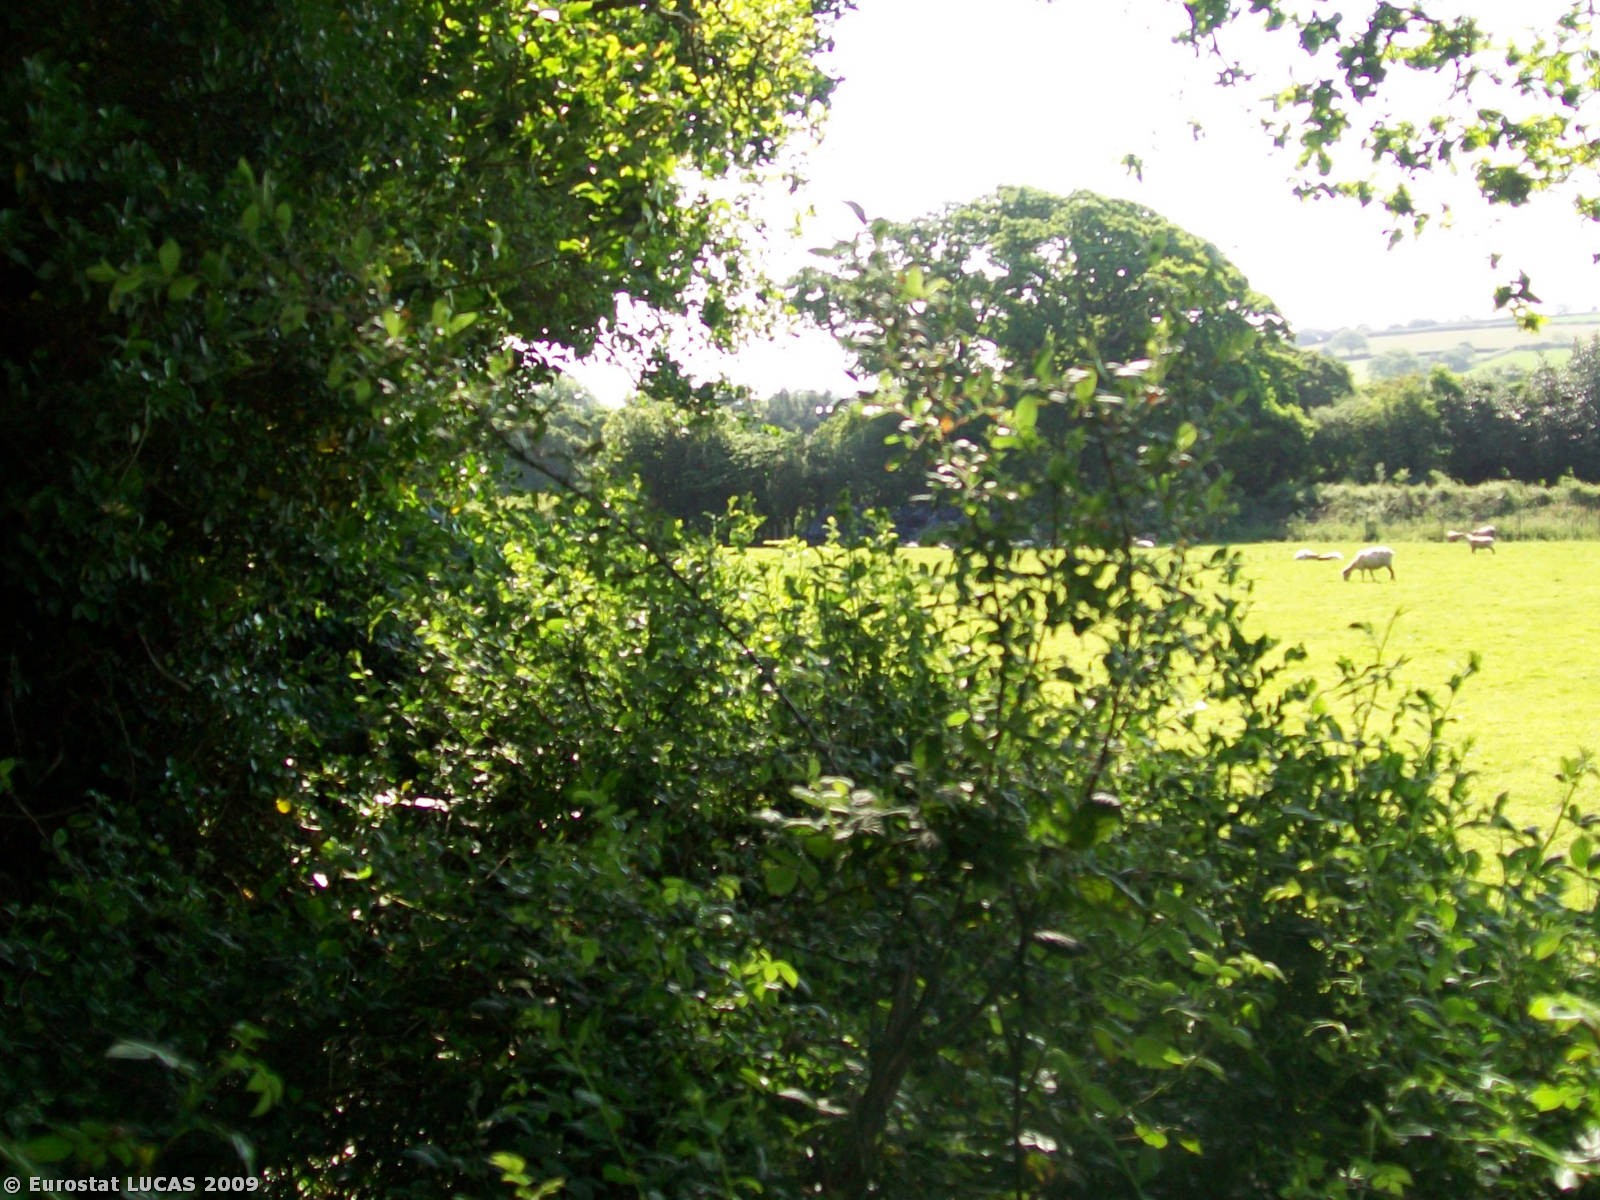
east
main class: Grassland
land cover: Grassland without tree/shrub cover
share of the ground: > 75 %
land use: Agriculture (excluding fallow land and kitchen gardens)
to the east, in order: Grassland without tree/shrub cover; Fences; Dry stone walls; Managed hedges; Tracks; Broadleaved woodland; Fences; Grassland without tree/shrub cover; Fences; Managed hedges; Grass margins; Paved roads, cycling and walking lanes; Grass margins
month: June
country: GB
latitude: 50.1791
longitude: -5.0870
